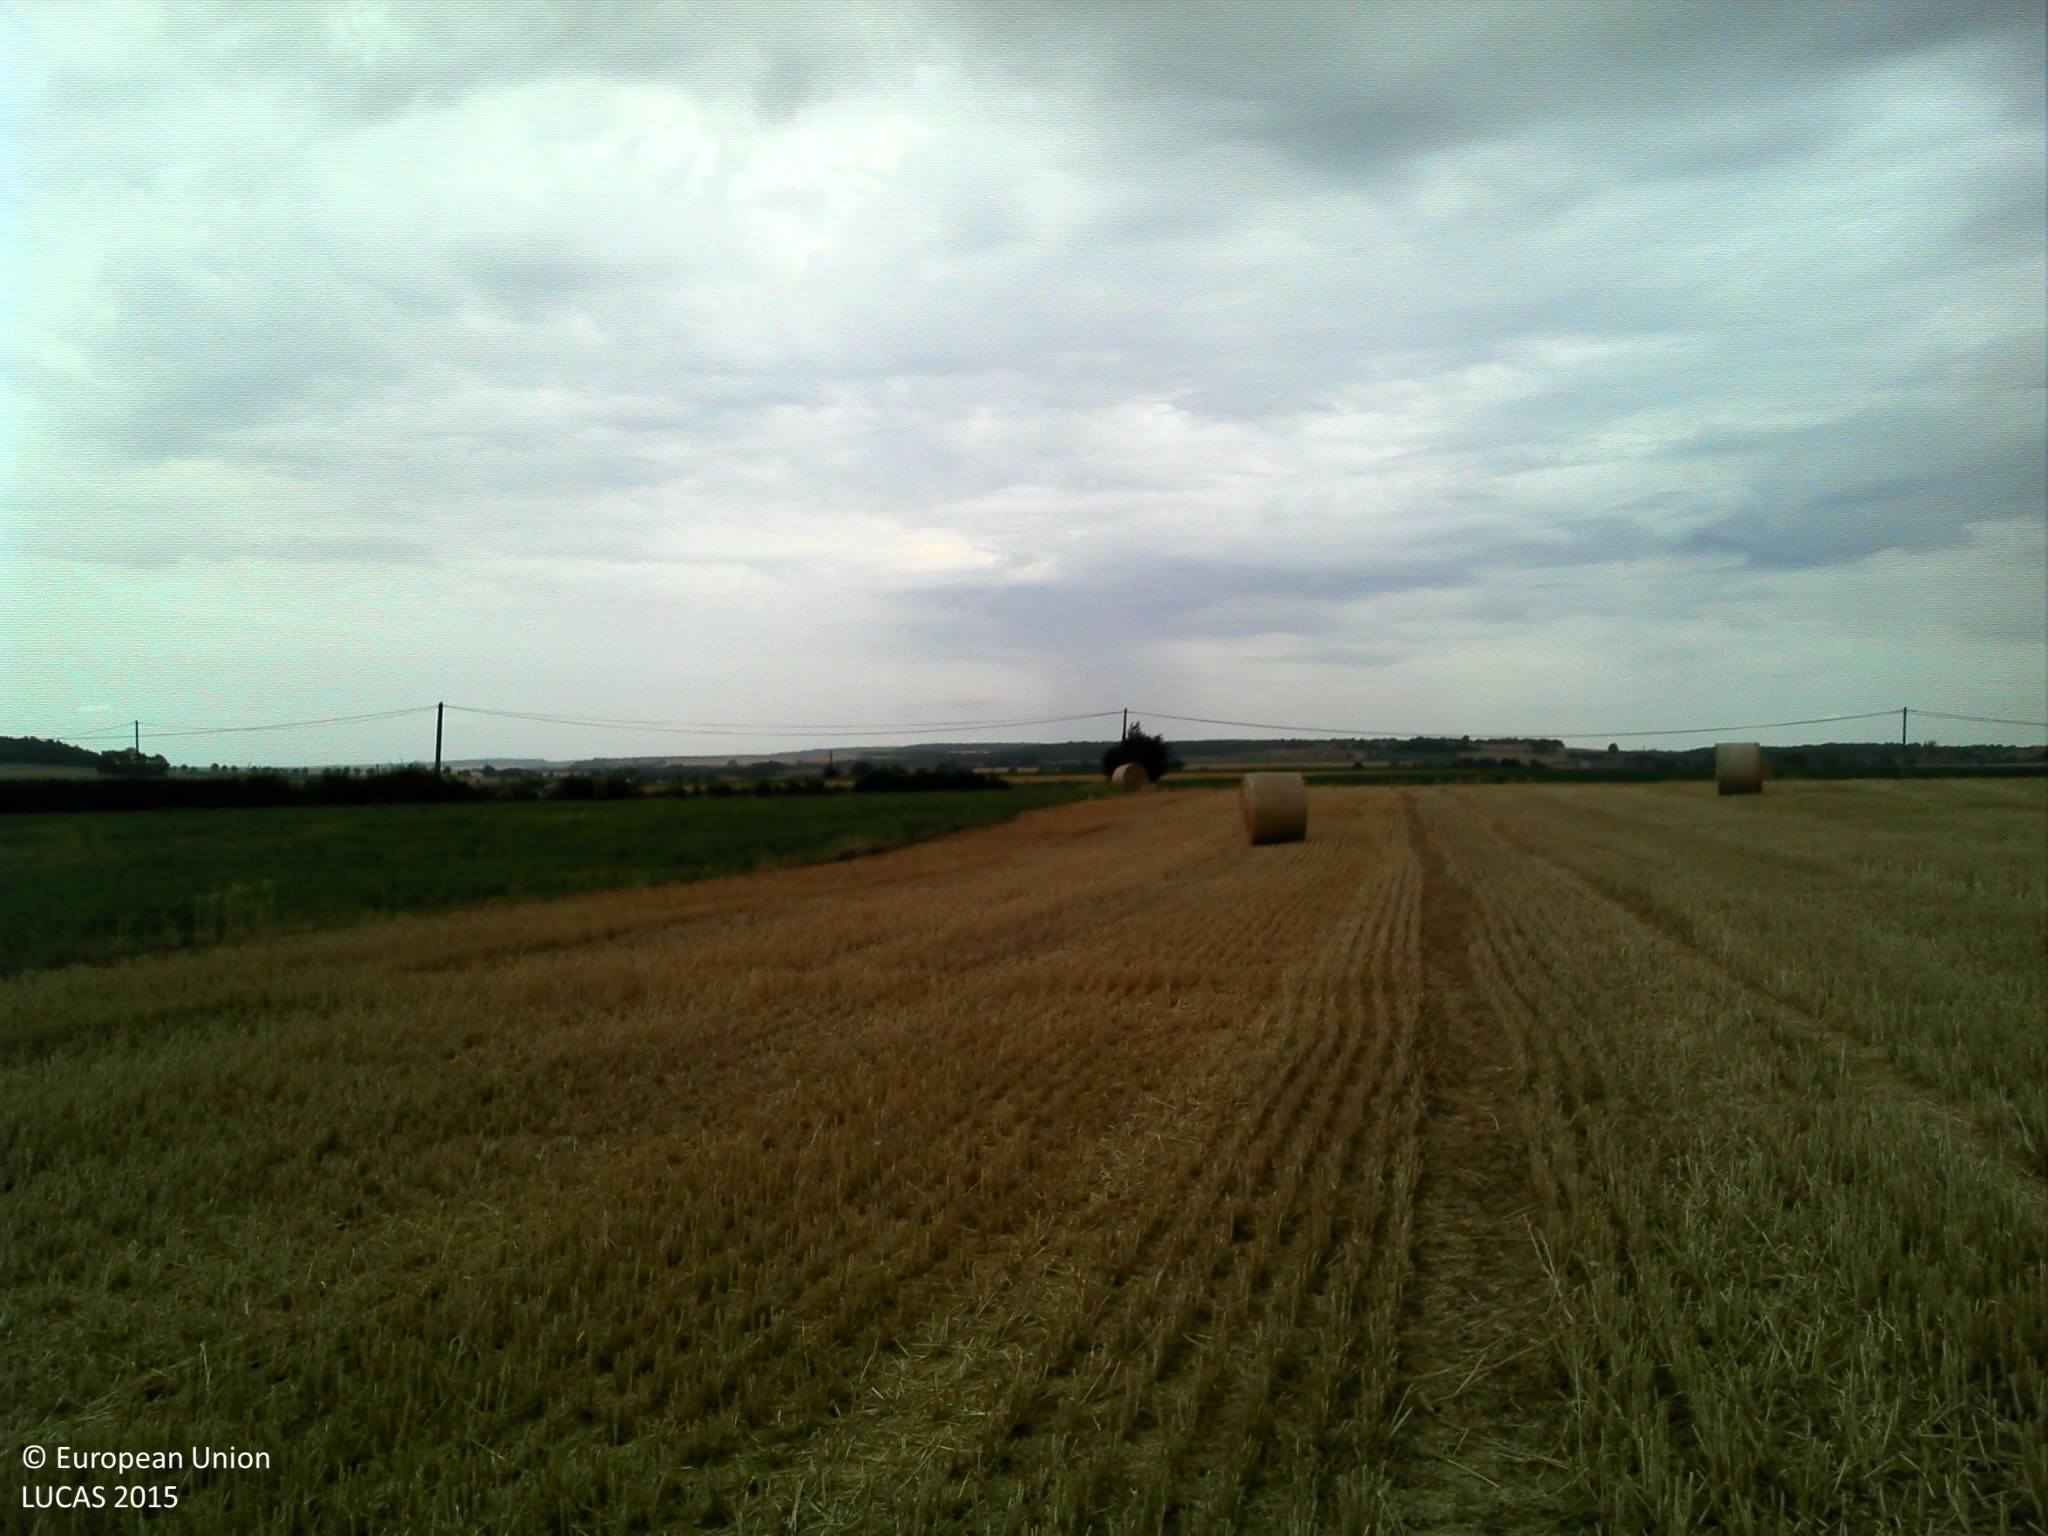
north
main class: Cropland
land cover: Common wheat
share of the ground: 10 - 25 %
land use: Agriculture (excluding fallow land and kitchen gardens)
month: July
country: FR
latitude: 47.8858
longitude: 5.2255
